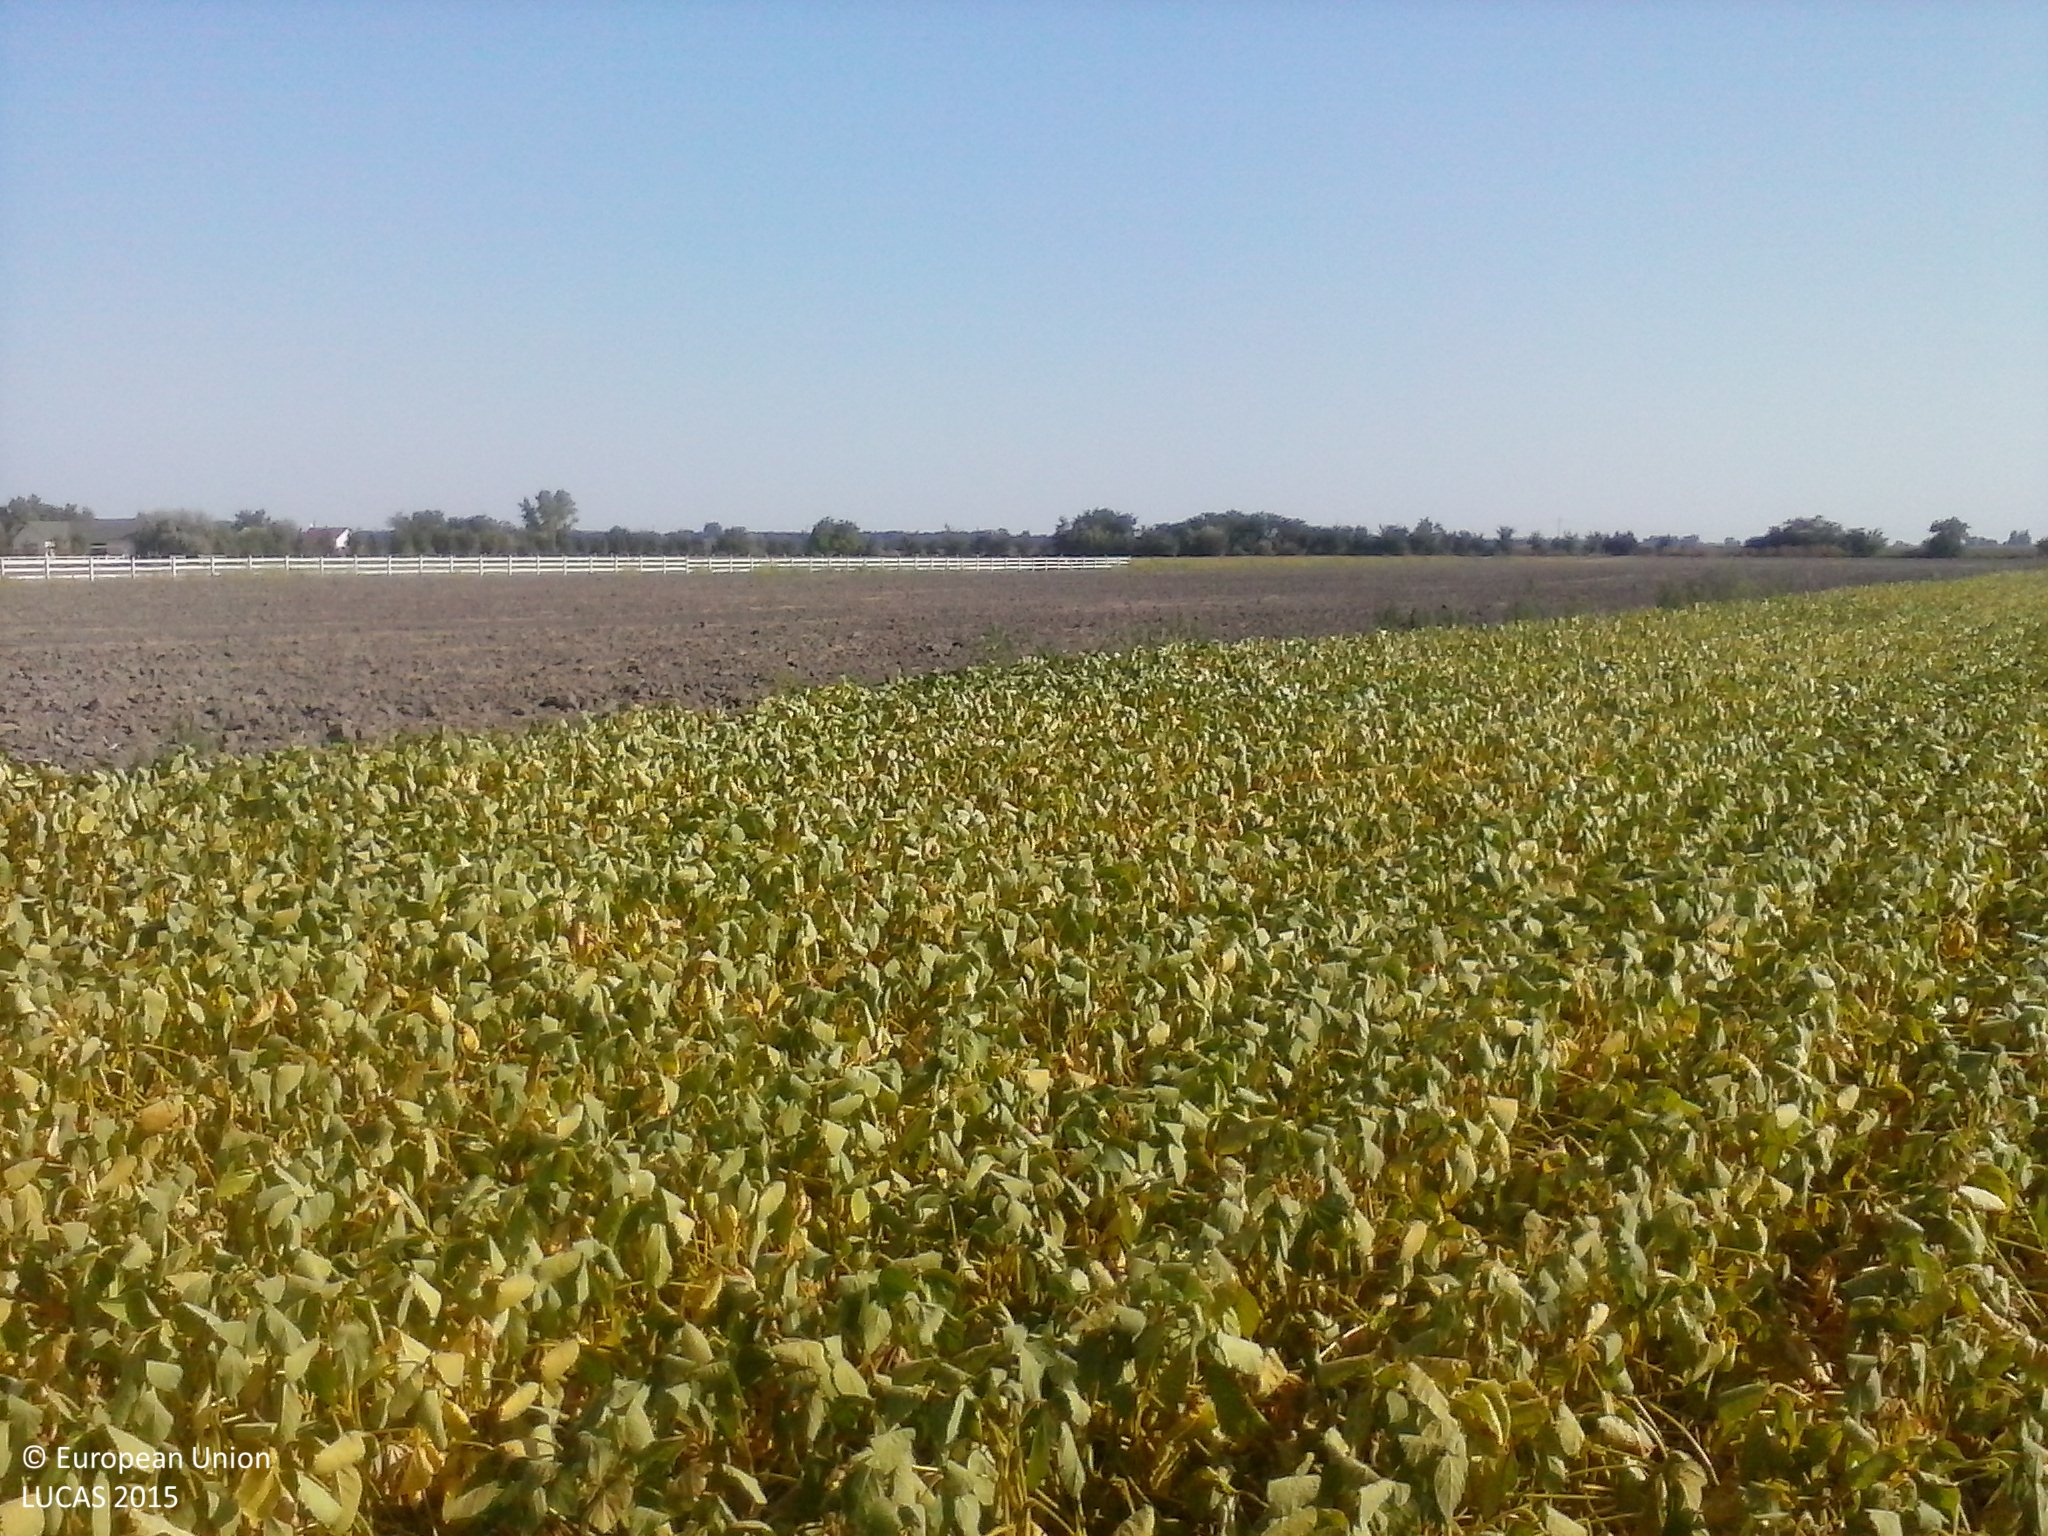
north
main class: Cropland
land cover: Soya
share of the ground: > 75 %
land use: Agriculture (excluding fallow land and kitchen gardens)
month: July
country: HU
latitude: 46.0193
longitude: 18.8588
